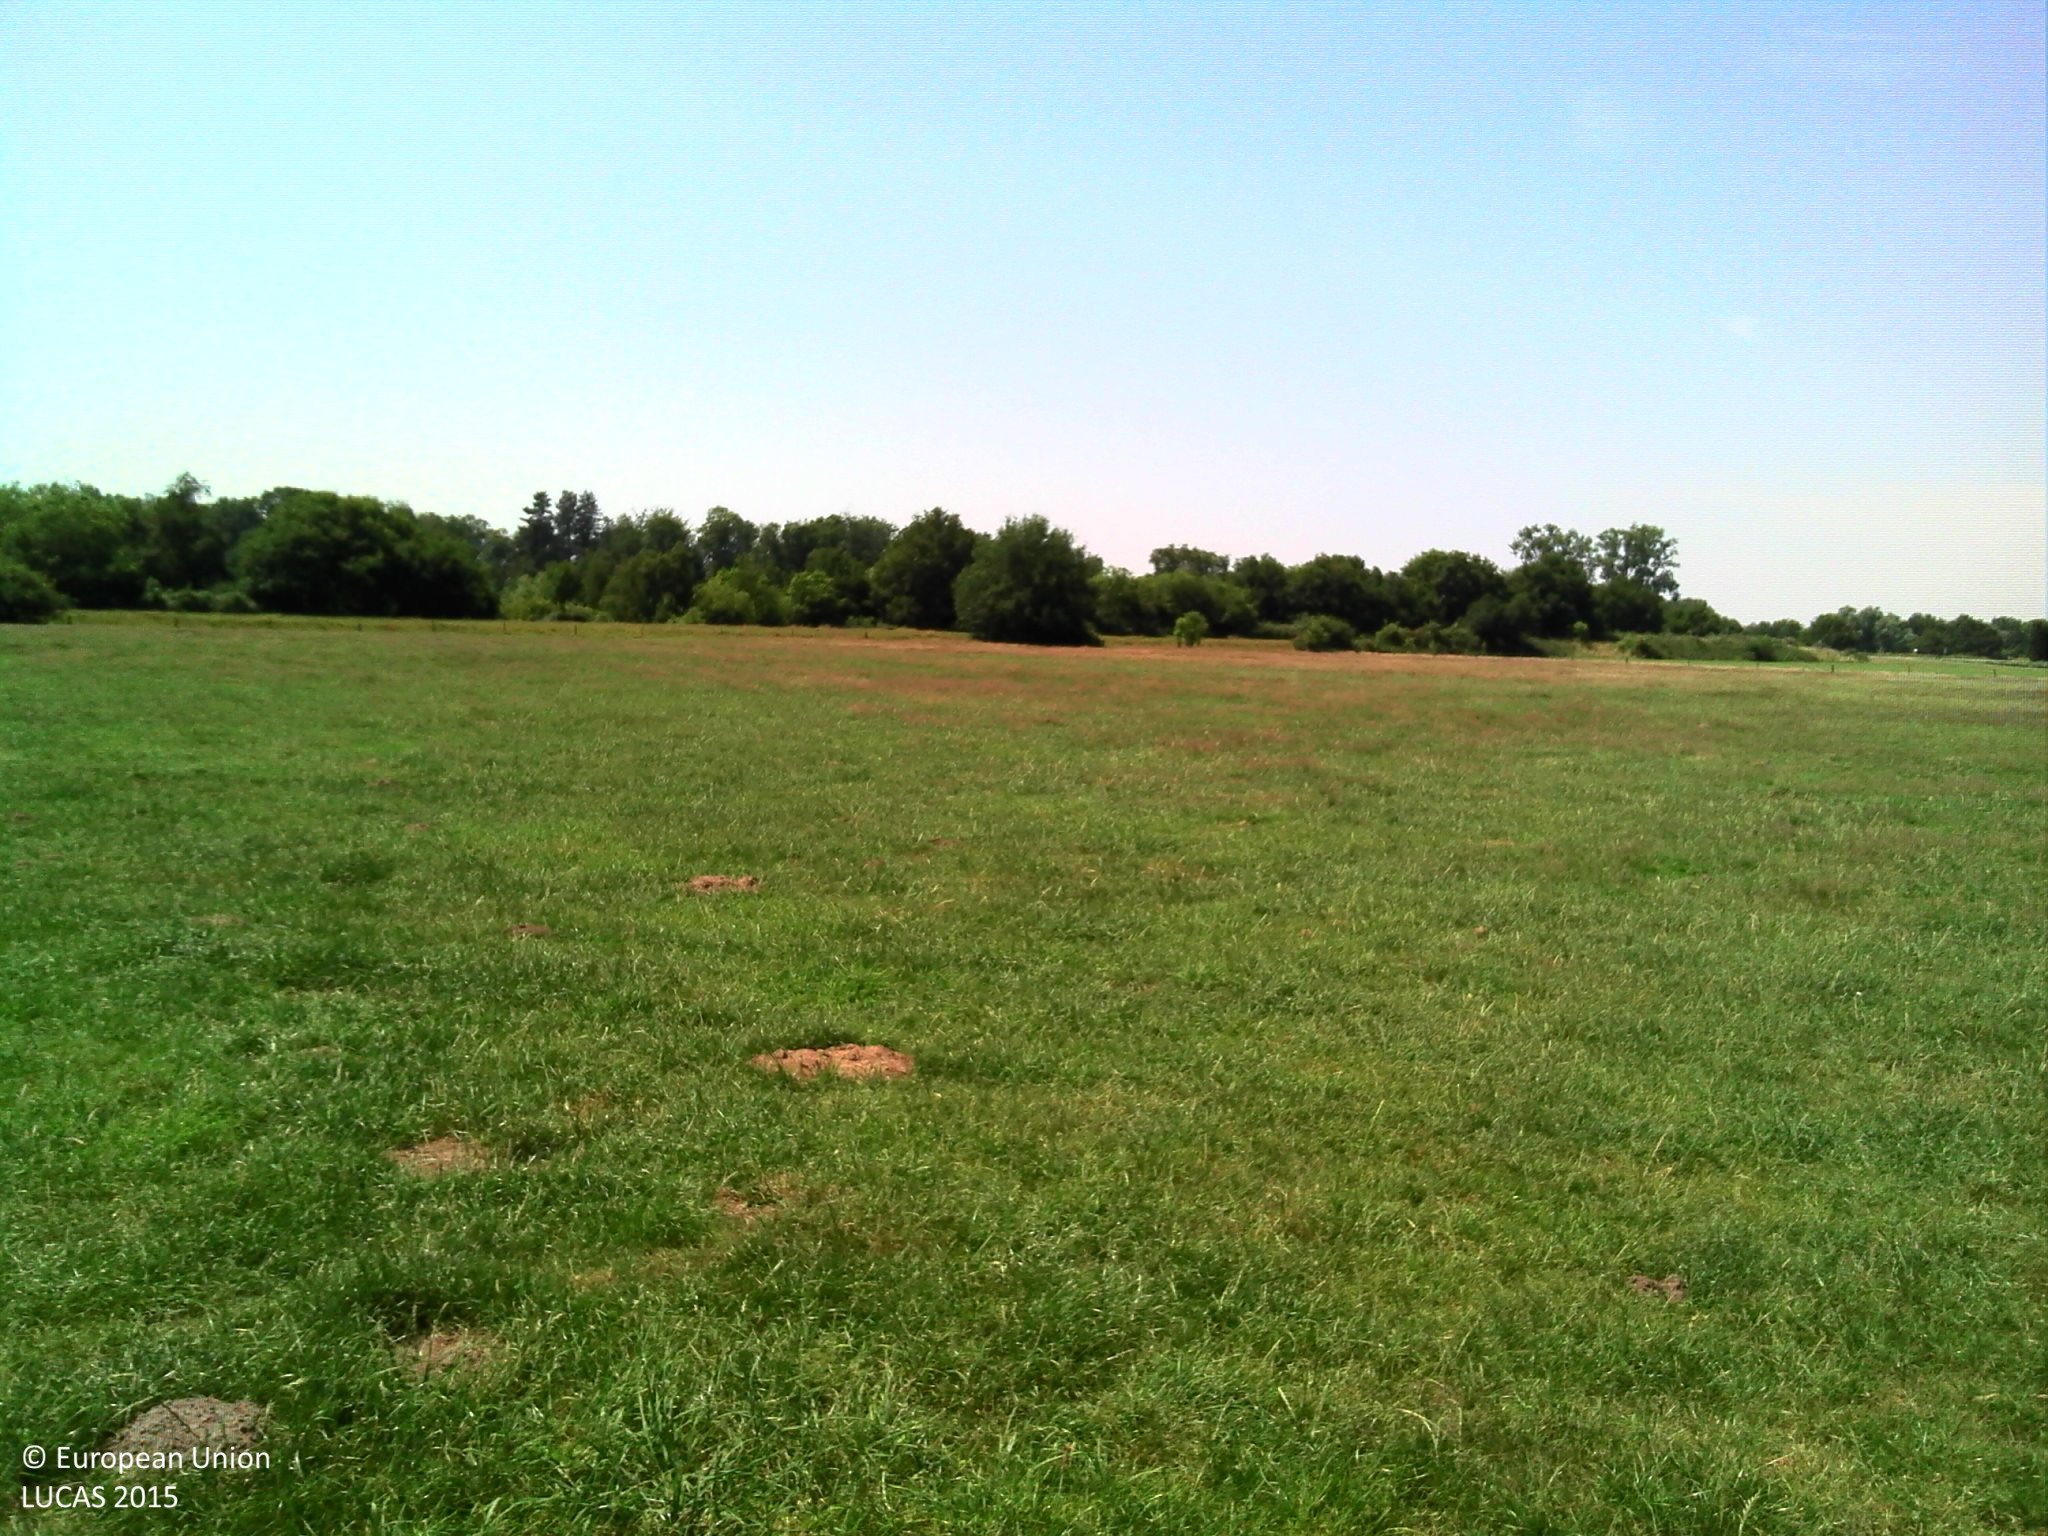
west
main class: Grassland
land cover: Grassland without tree/shrub cover
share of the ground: > 75 %
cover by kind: herbaceous plants 100 %
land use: Agriculture (excluding fallow land and kitchen gardens)
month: July
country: BE
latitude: 51.1119
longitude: 3.4068
